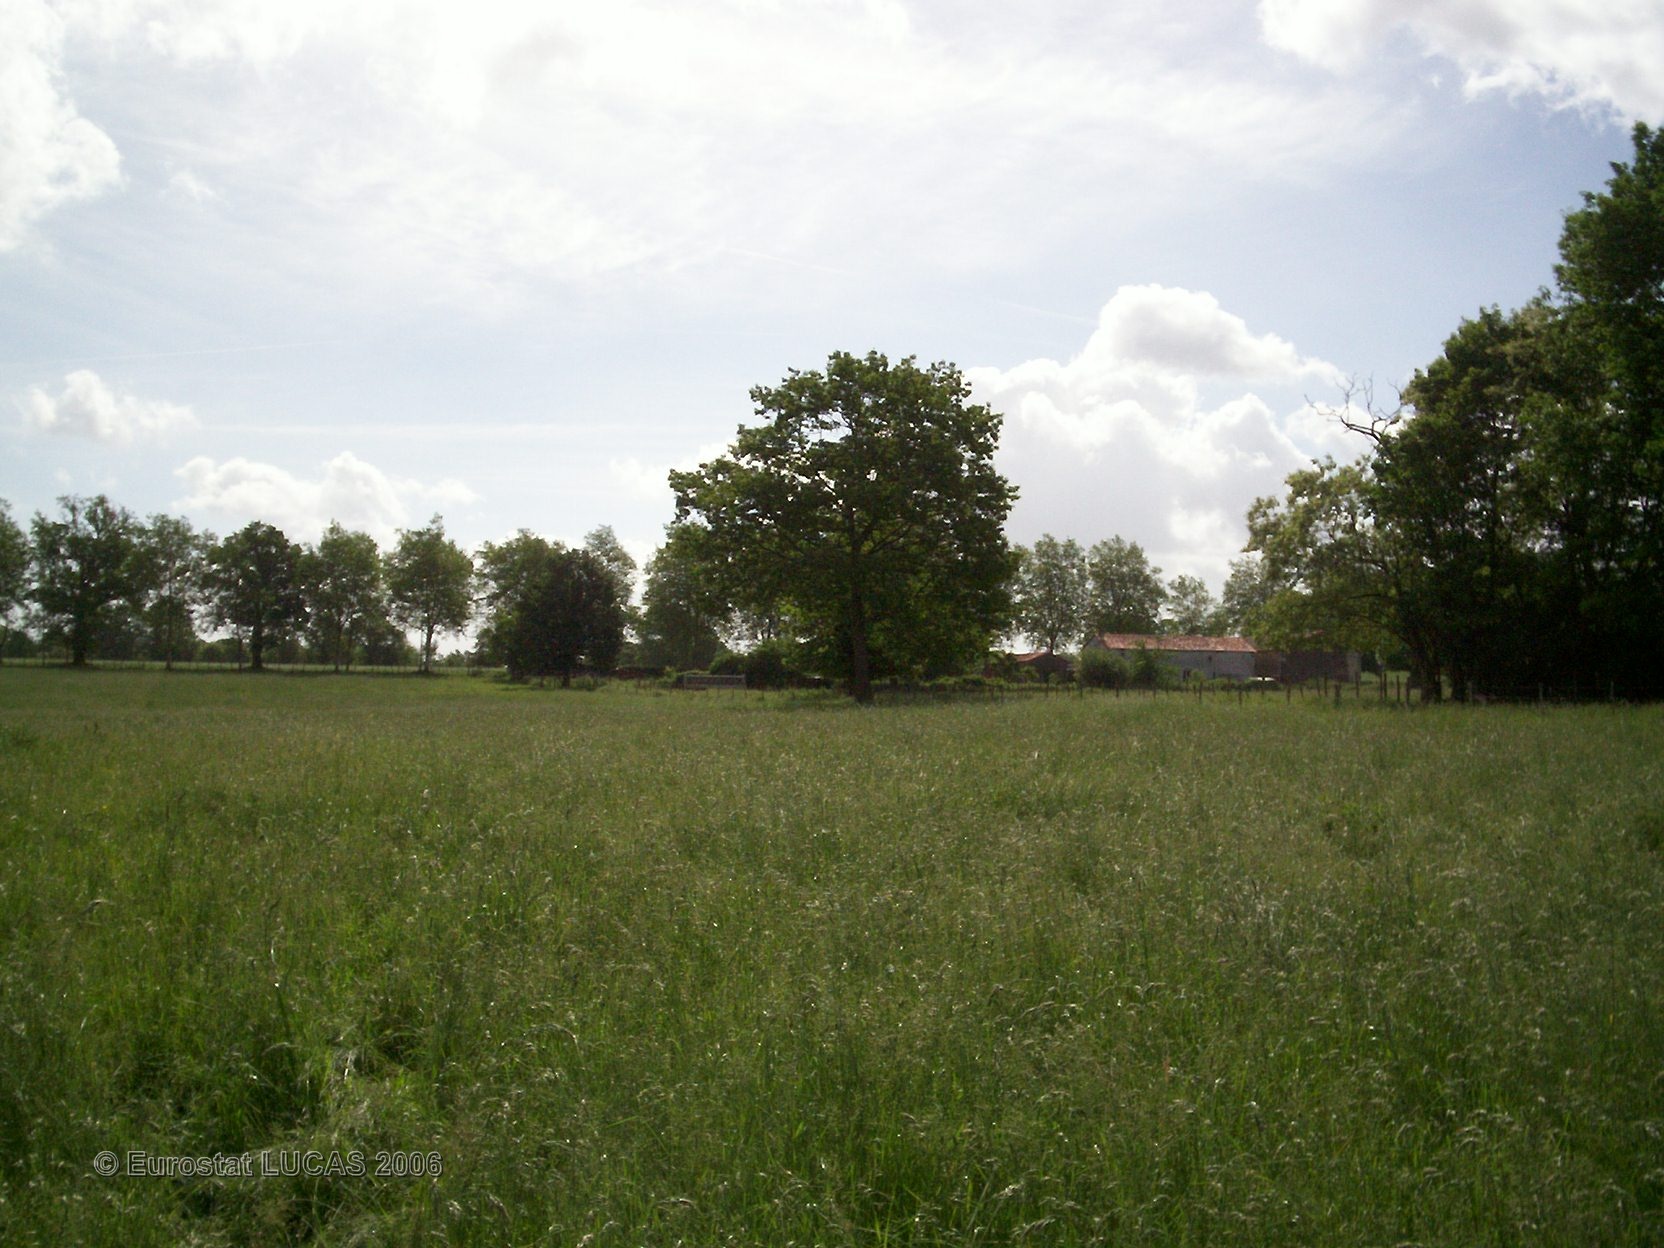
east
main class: Grassland
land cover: Grassland without tree/shrub cover
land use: Agriculture (excluding fallow land and kitchen gardens)
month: May
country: FR
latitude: 45.8878
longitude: 0.4619
